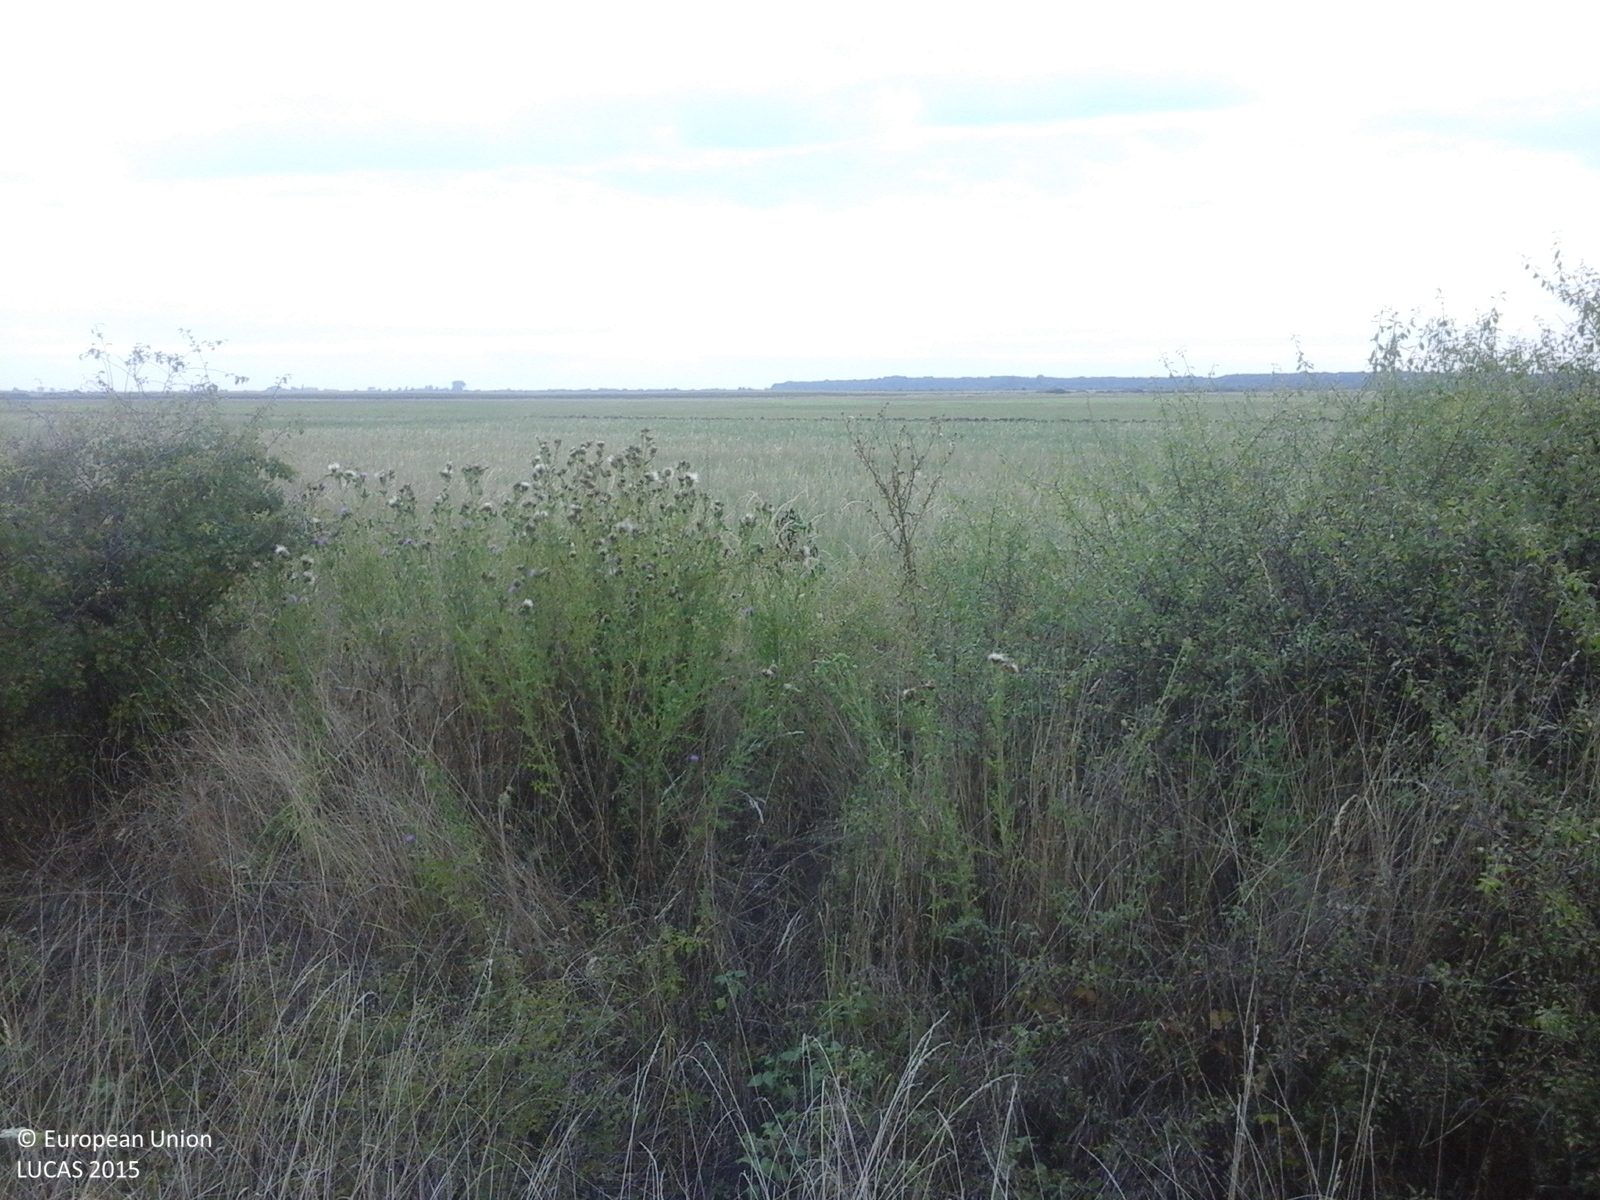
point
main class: Cropland
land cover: Common wheat
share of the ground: 50 - 75 %
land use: Agriculture (excluding fallow land and kitchen gardens)
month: August
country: RO
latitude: 45.3407
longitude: 21.2201
